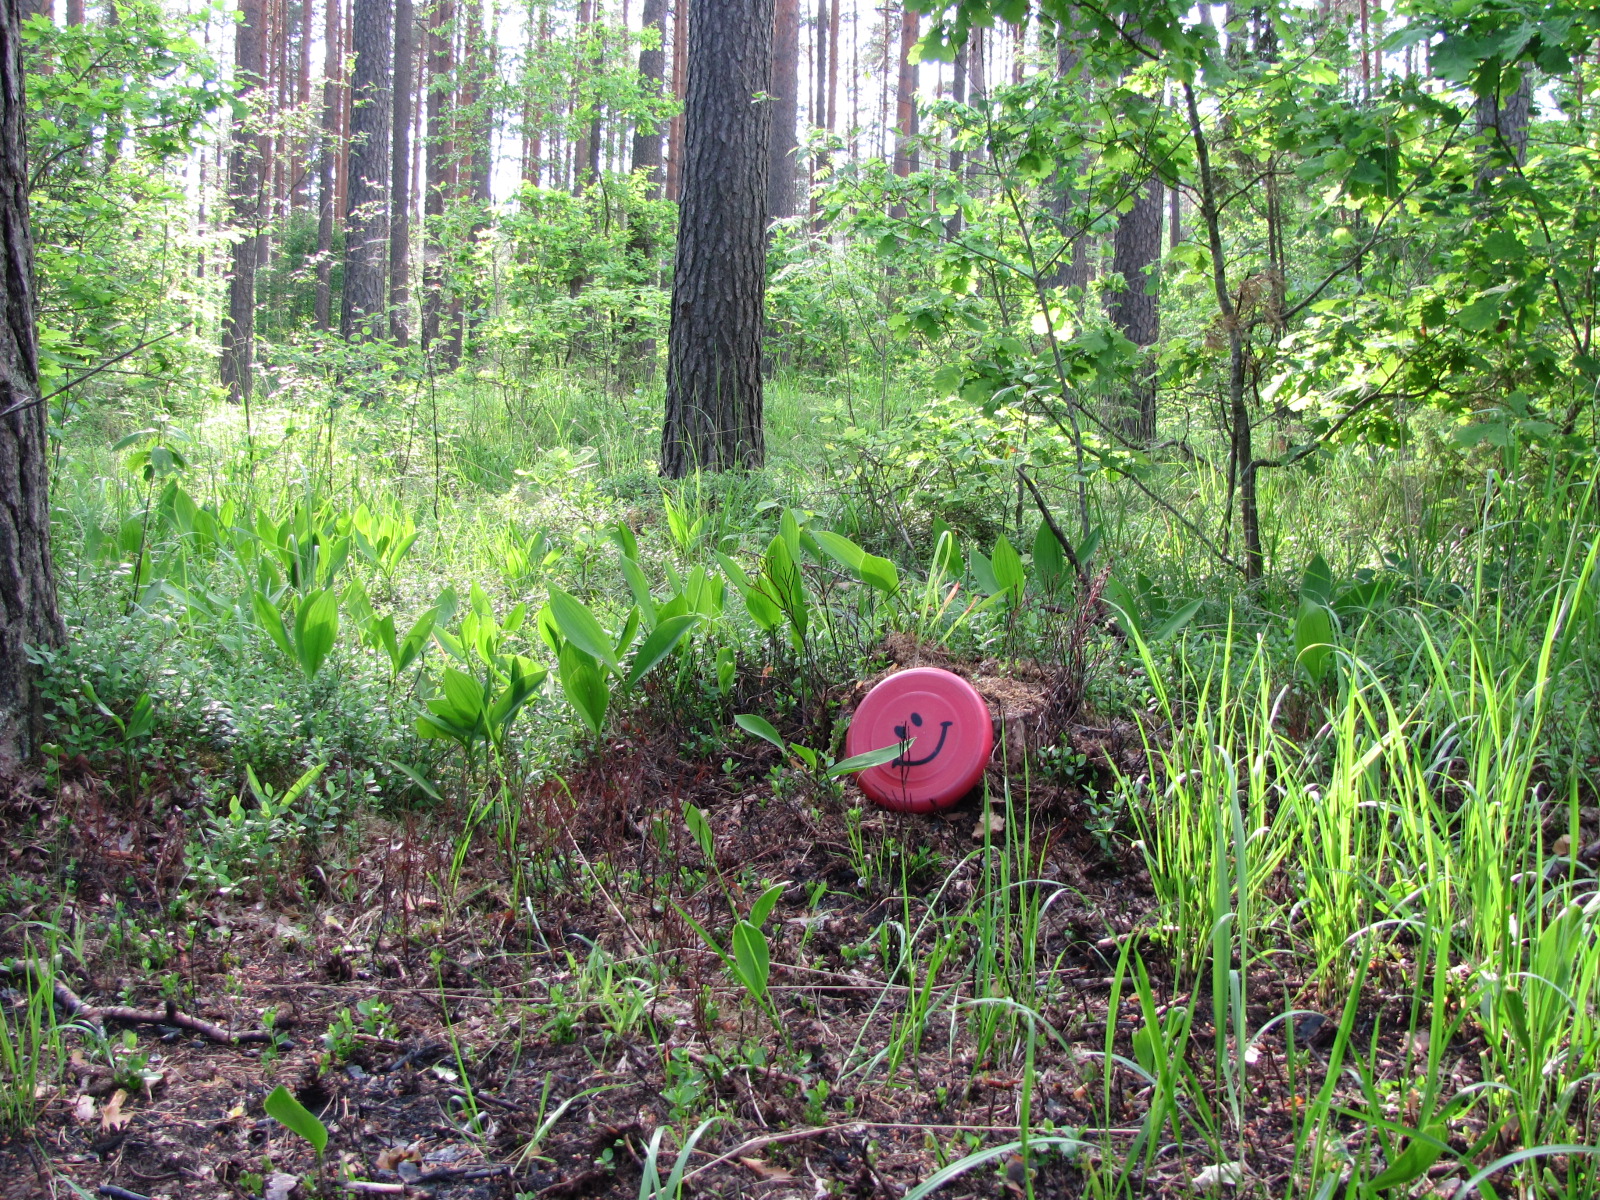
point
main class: Woodland
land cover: Pine dominated mixed woodland
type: hemiboreal forest and nemoral coniferous forest and mixed broadleaved-coniferous forest
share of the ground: > 75 %
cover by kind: coniferous forest trees 60 %, broadleaved forest trees 30 %, herbaceous plants 10 %
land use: Forestry
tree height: > 5 m
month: June
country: LV
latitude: 56.9323
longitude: 24.3376
